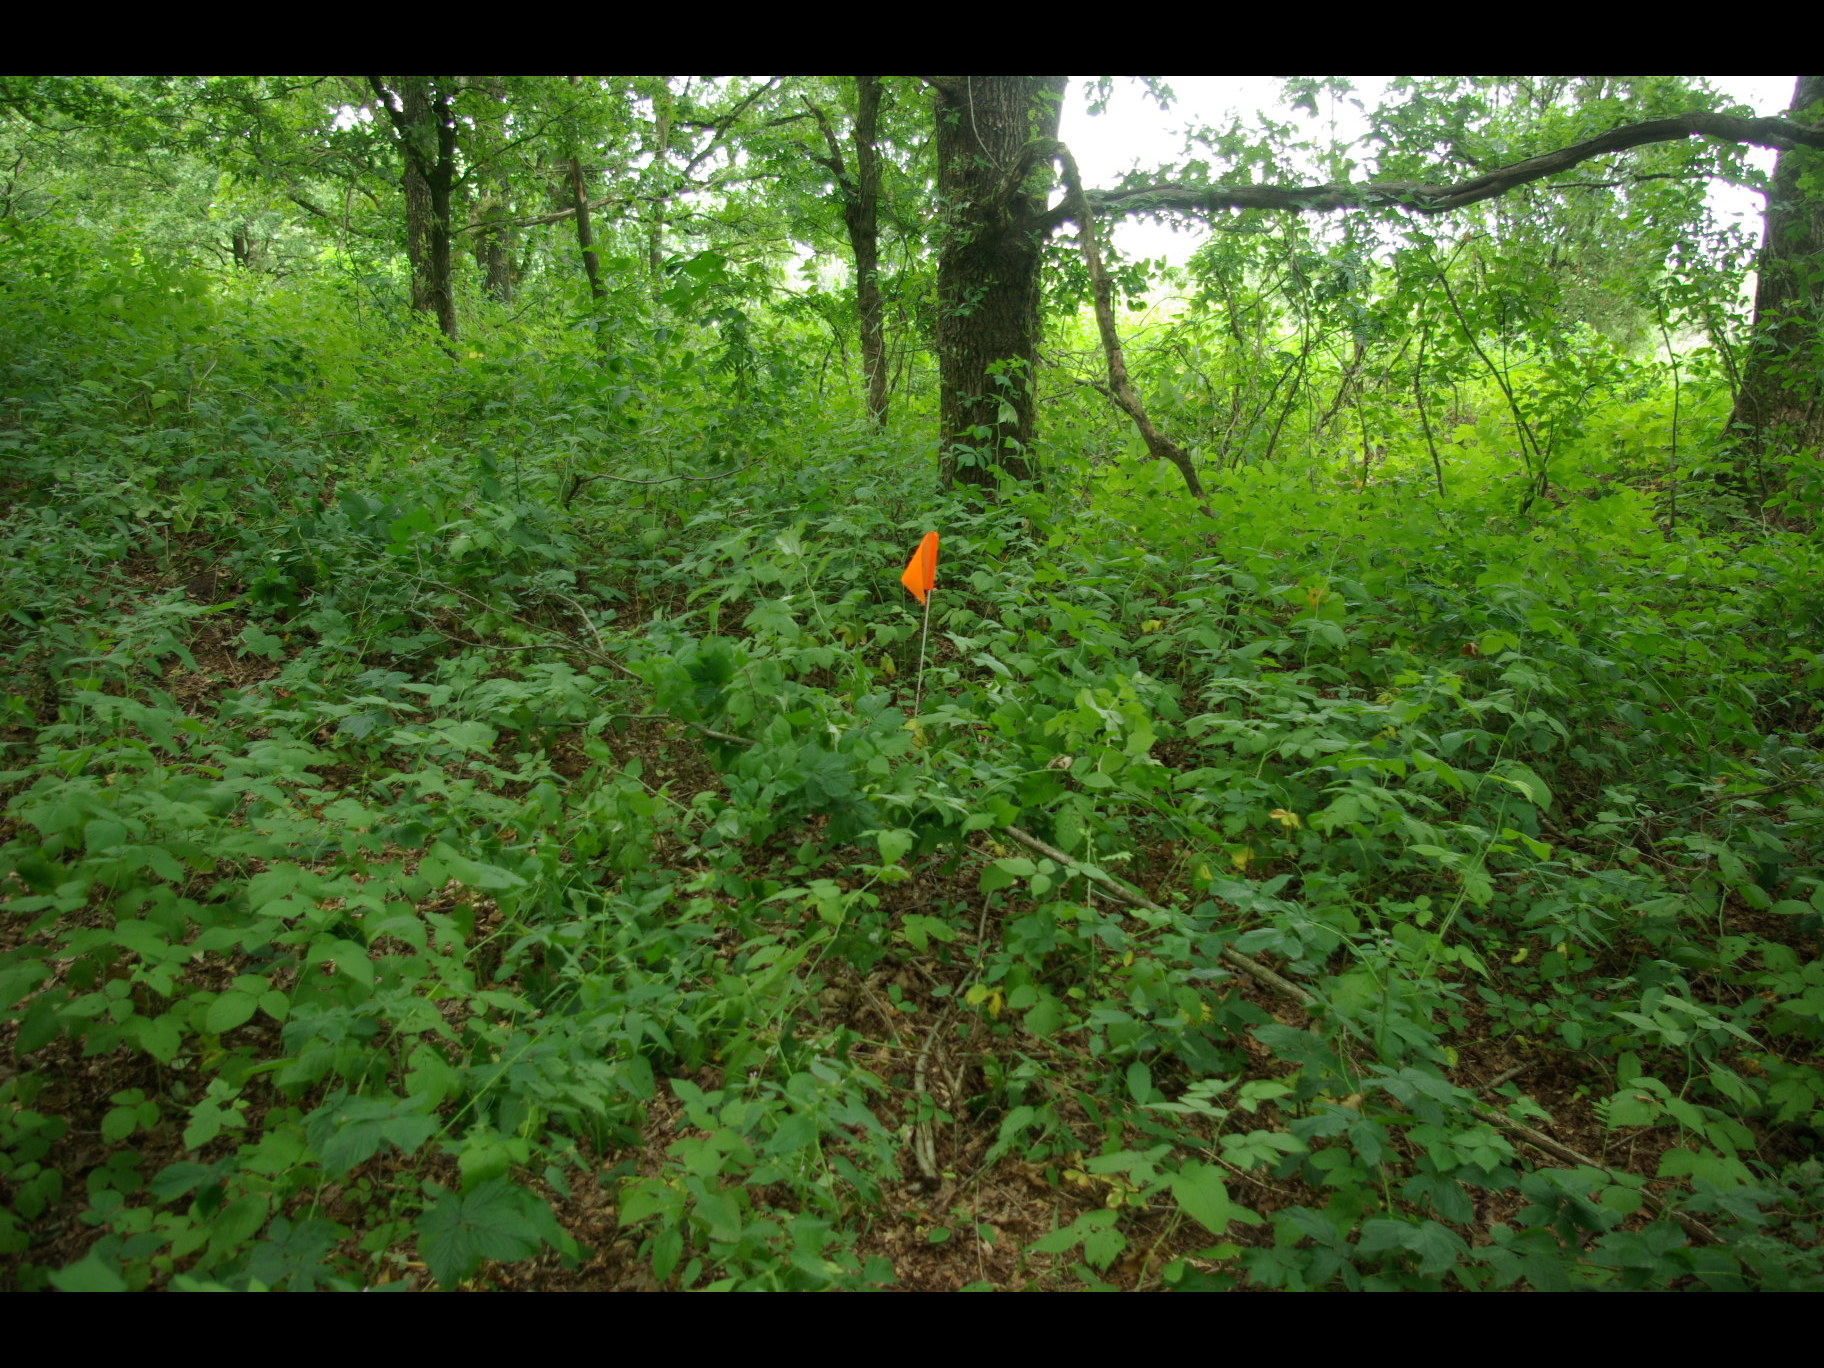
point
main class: Woodland
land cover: Broadleaved woodland
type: mesophytic deciduous forest
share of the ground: > 75 %
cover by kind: broadleaved forest trees 80 %, shrubs 10 %, herbaceous plants 10 %
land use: Semi-natural and natural areas not in use
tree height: > 5 m
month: August
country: DE
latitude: 54.6219
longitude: 9.2726
